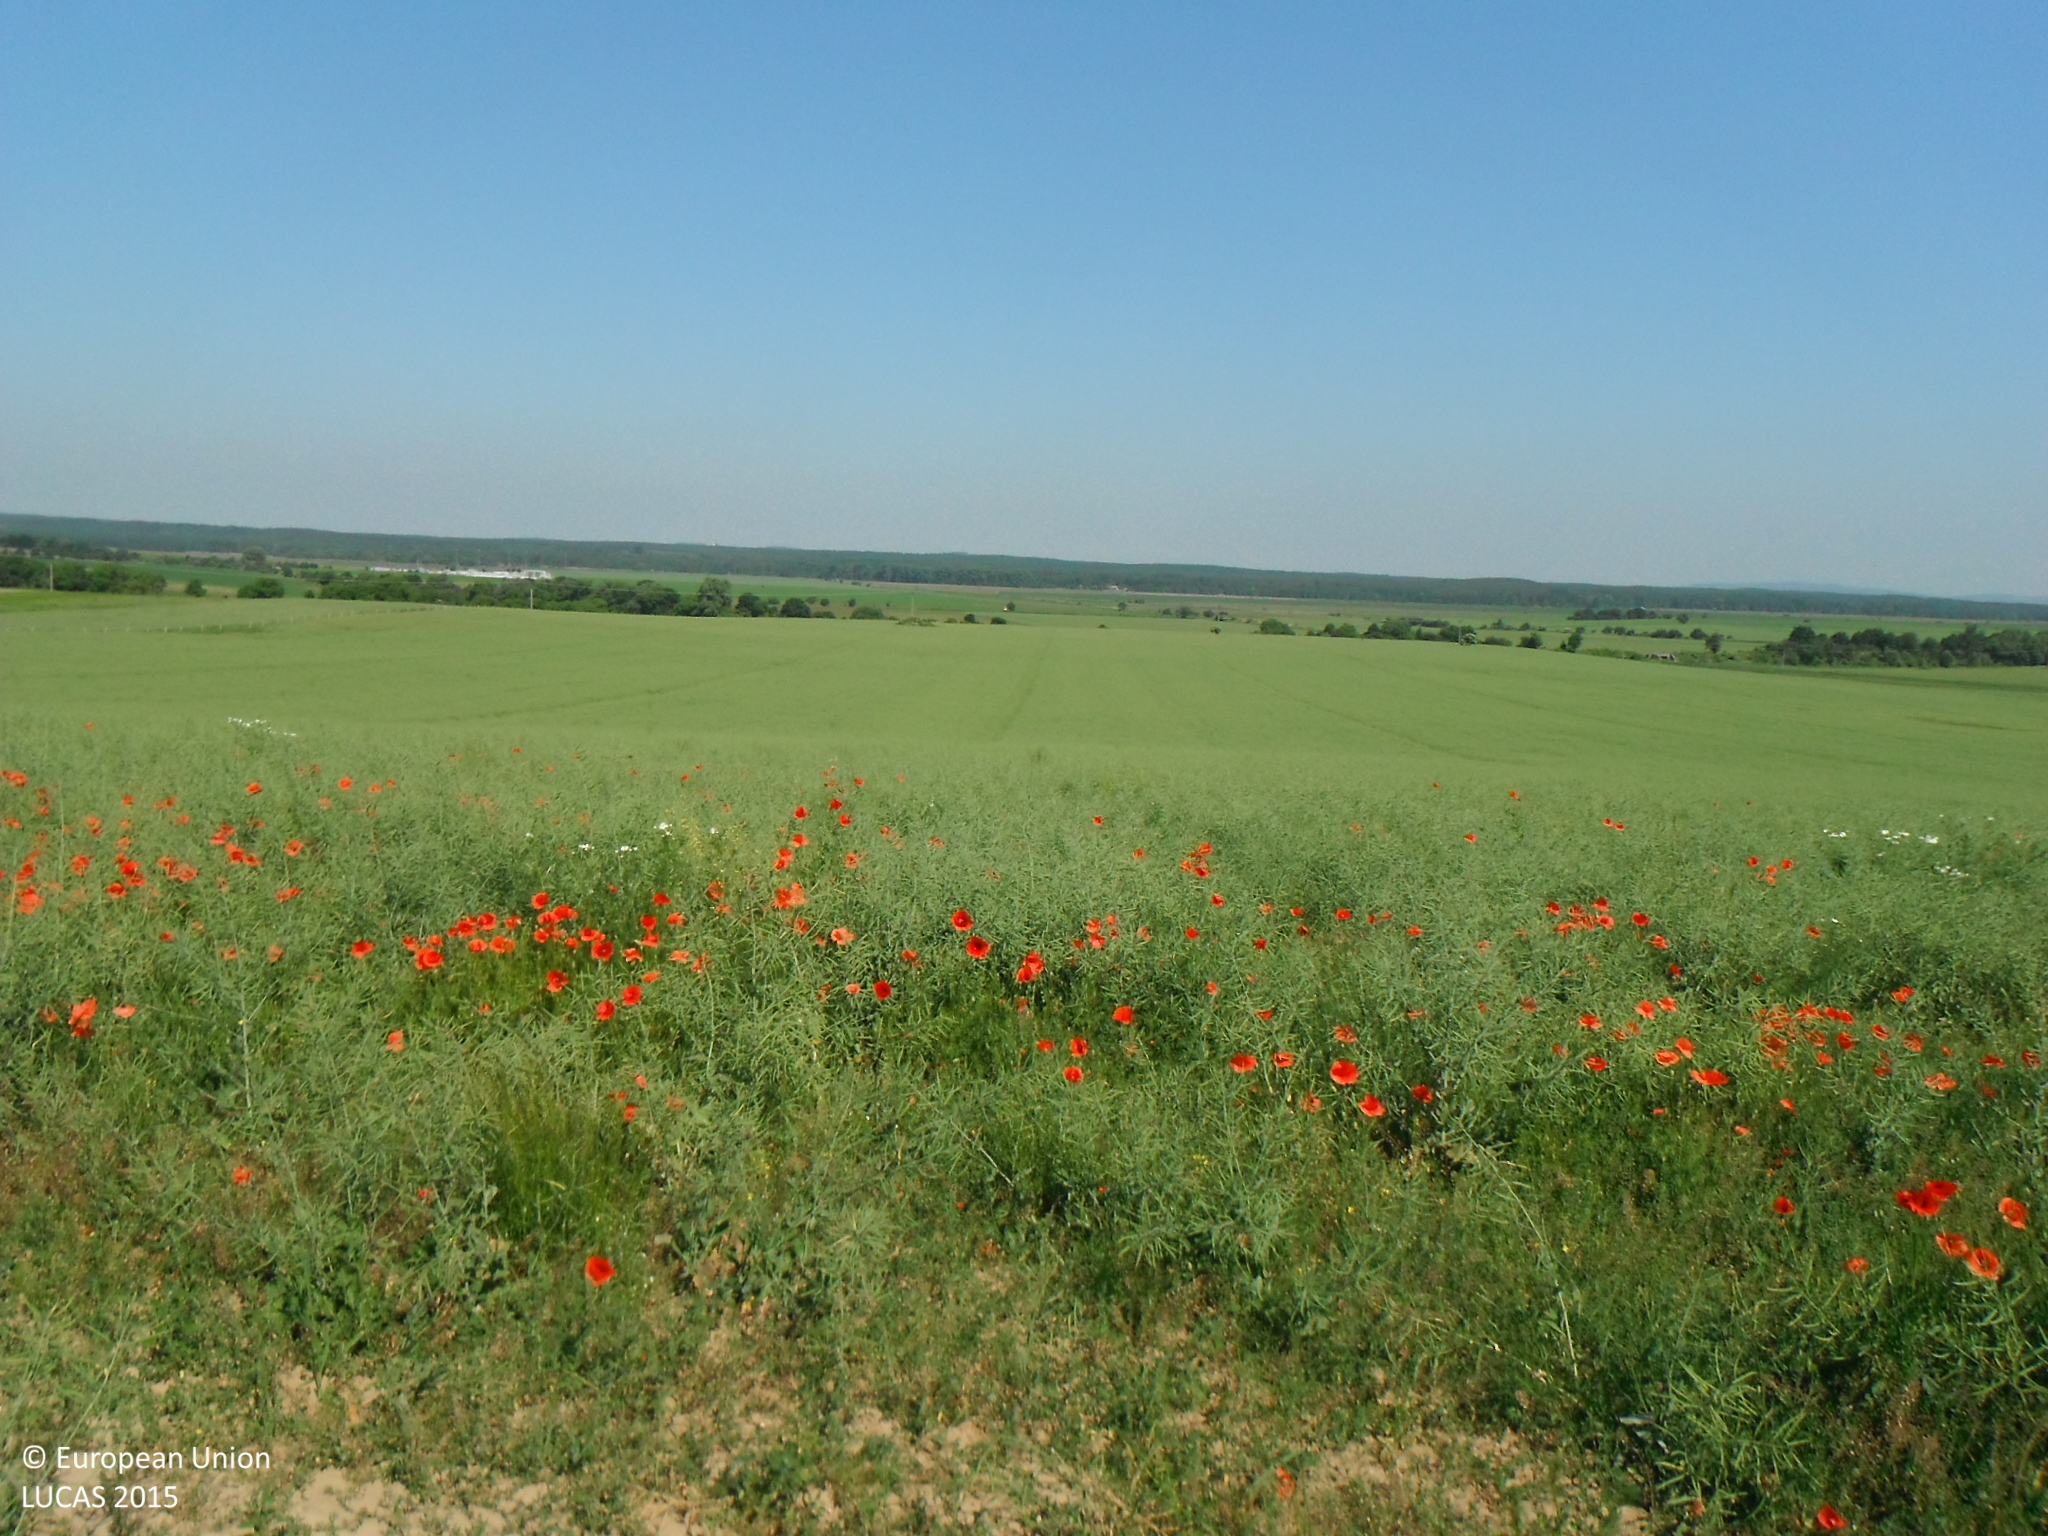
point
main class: Cropland
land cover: Rape and turnip rape
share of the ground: > 75 %
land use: Agriculture (excluding fallow land and kitchen gardens)
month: June
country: SK
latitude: 48.5390
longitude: 17.3372
